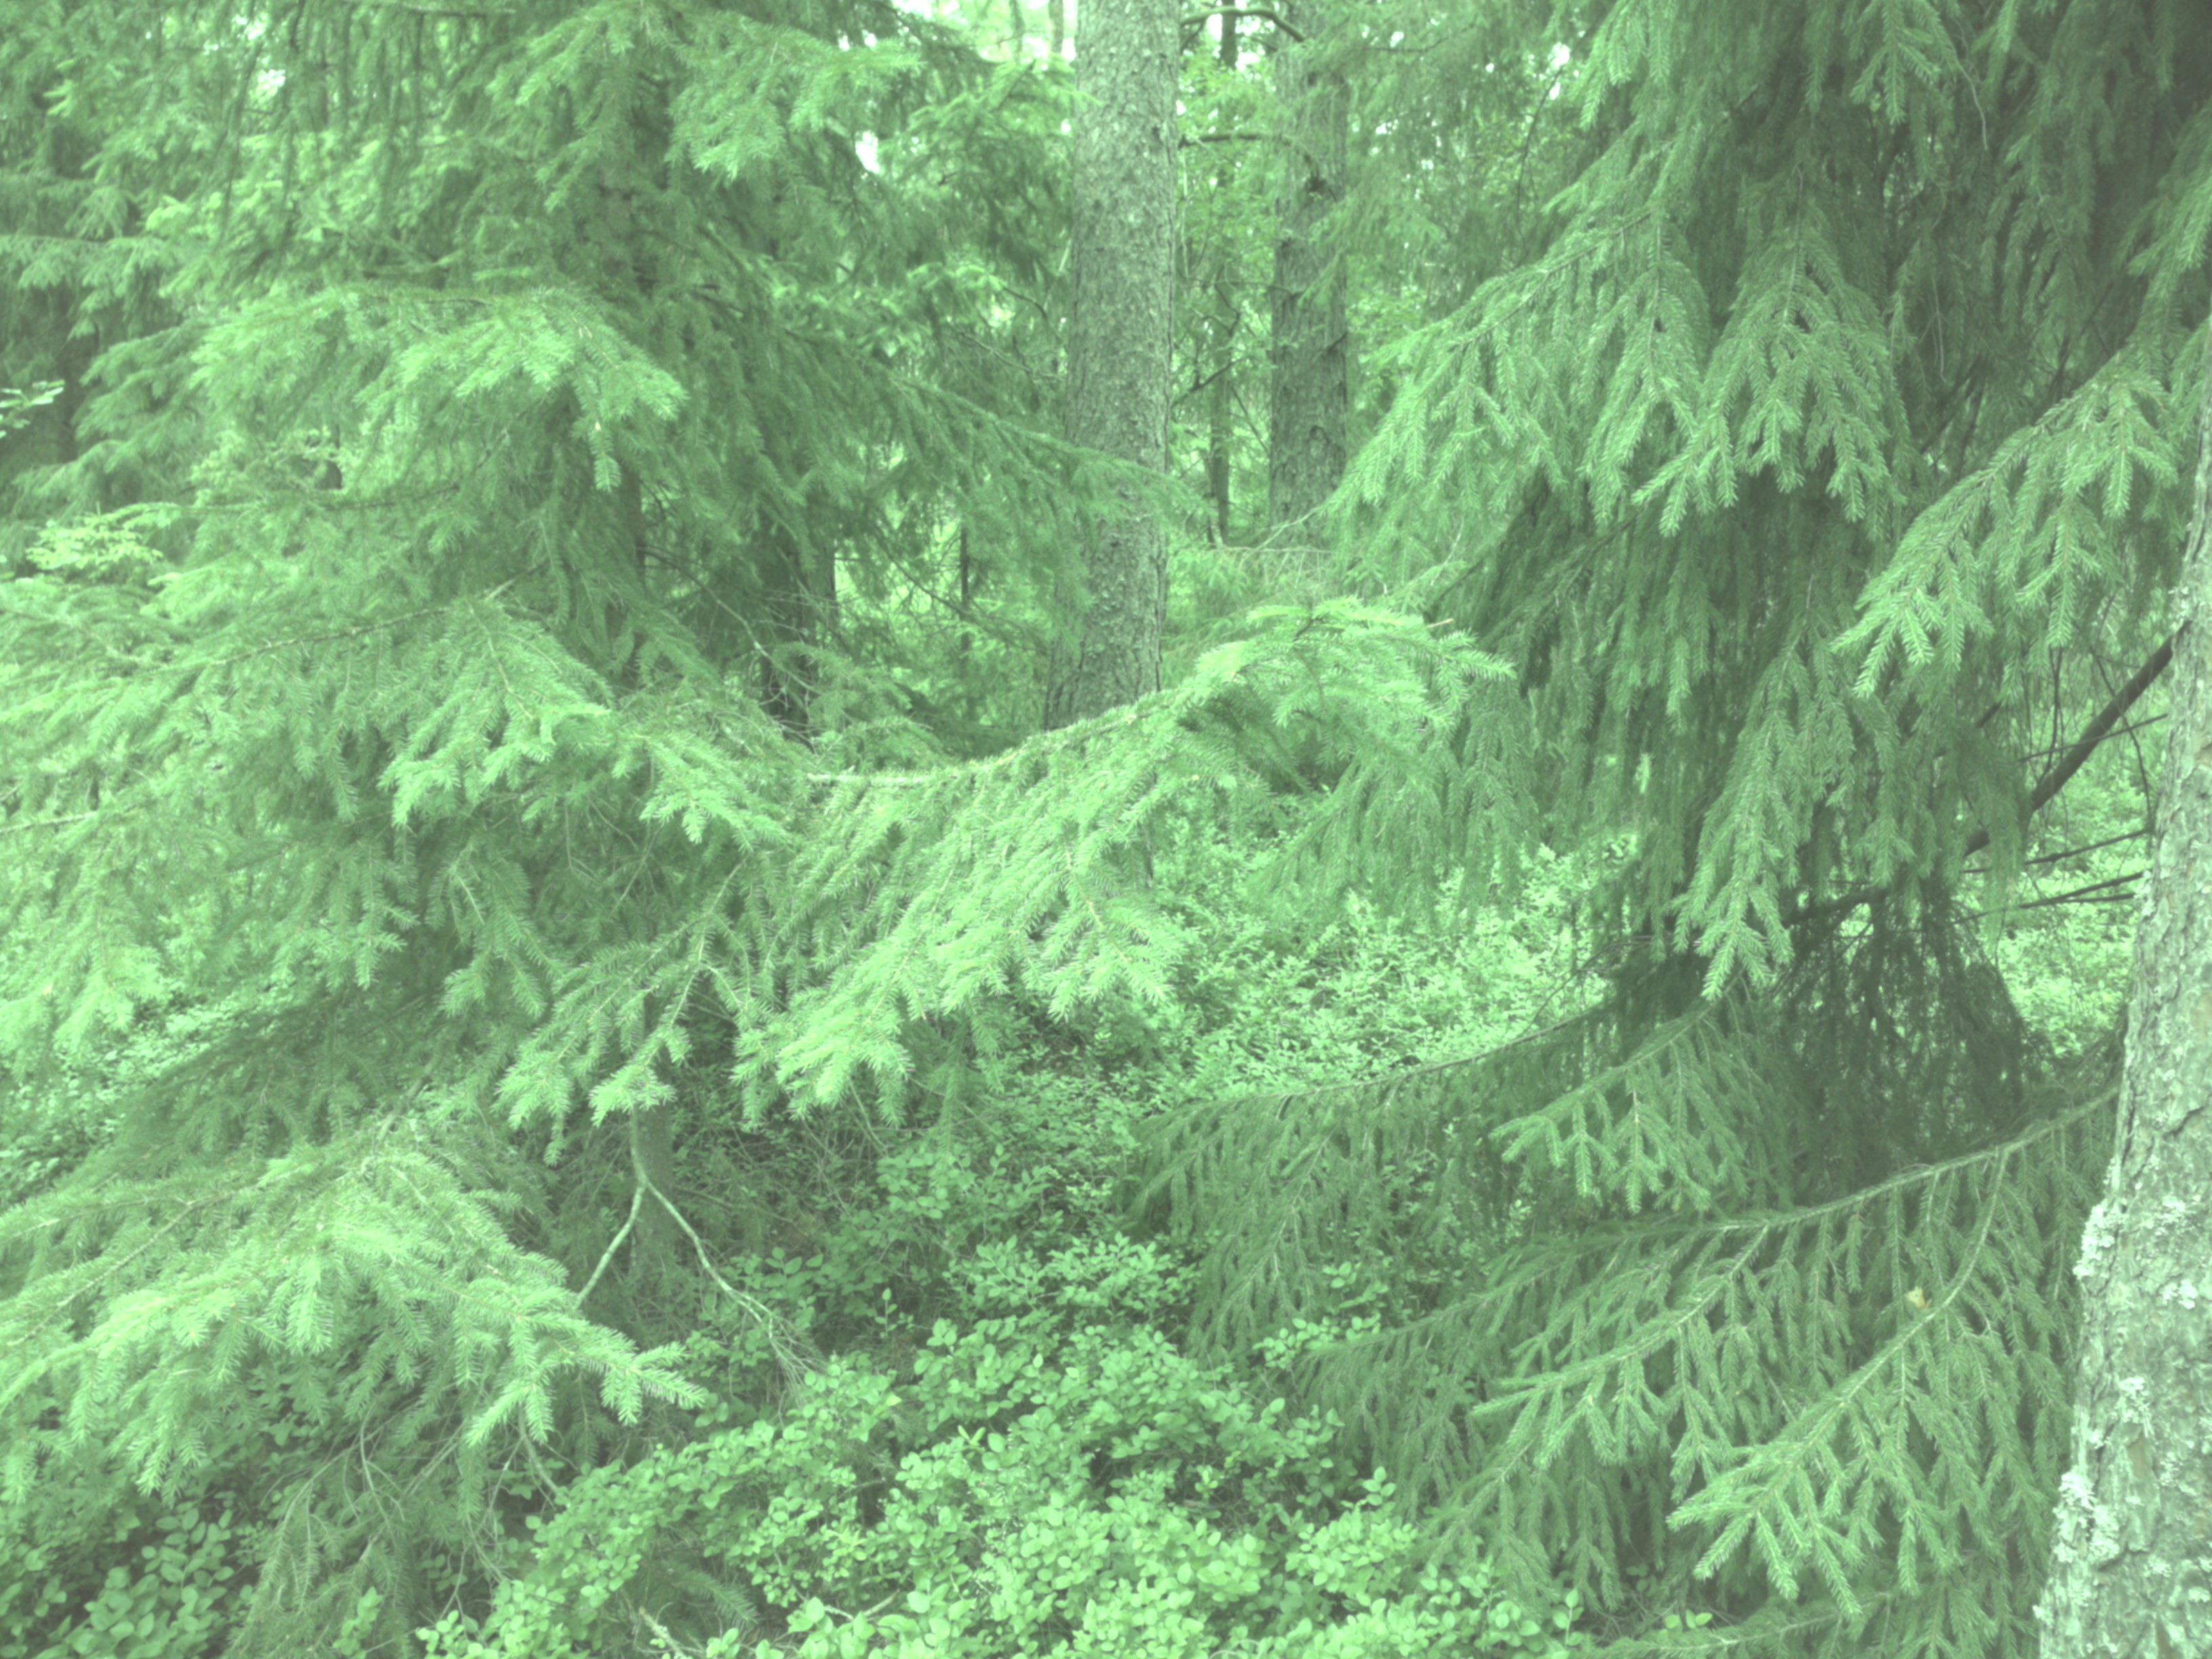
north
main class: Woodland
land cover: Pine dominated coniferous woodland
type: boreal forest
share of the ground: 50 - 75 %
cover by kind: coniferous forest trees 70 %, shrubs 25 %, herbaceous plants 5 %
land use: Forestry
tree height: > 5 m
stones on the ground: < 10 %
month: June
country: SE
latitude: 59.2563
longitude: 17.5204
